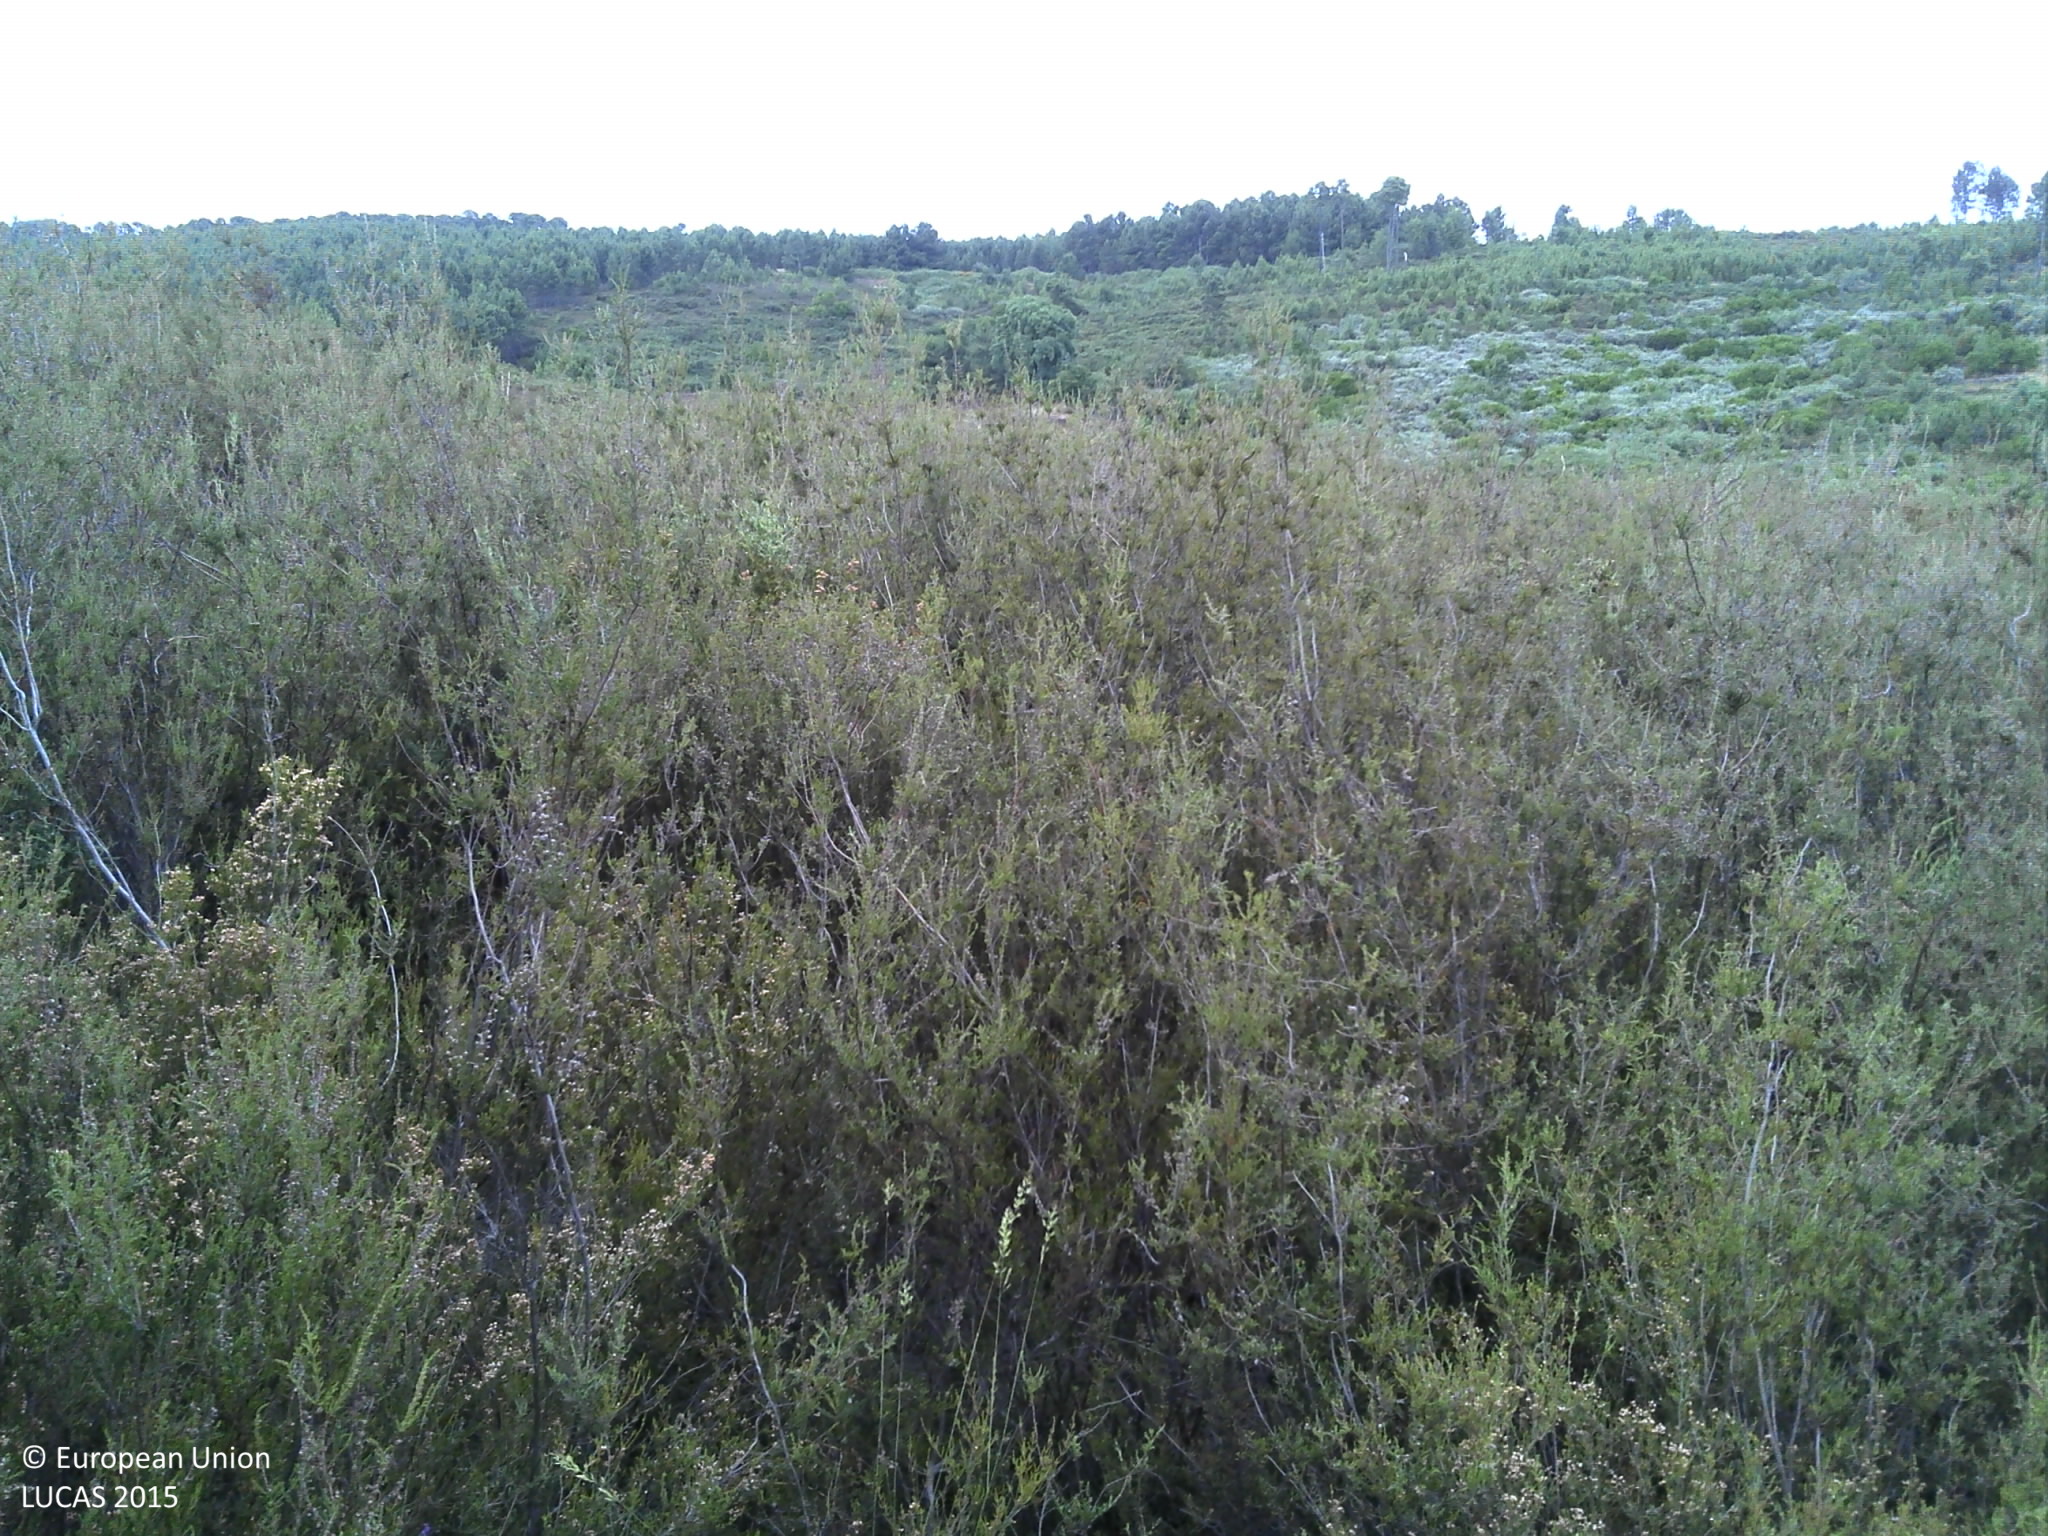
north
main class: Shrubland
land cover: Shrubland with sparse tree cover
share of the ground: > 75 %
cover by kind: shrubs 95 %, coniferous forest trees 5 %
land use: Semi-natural and natural areas not in use
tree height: < 5 m
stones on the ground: 10 - 25 %
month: June
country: PT
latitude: 41.2454
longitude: -7.7057
